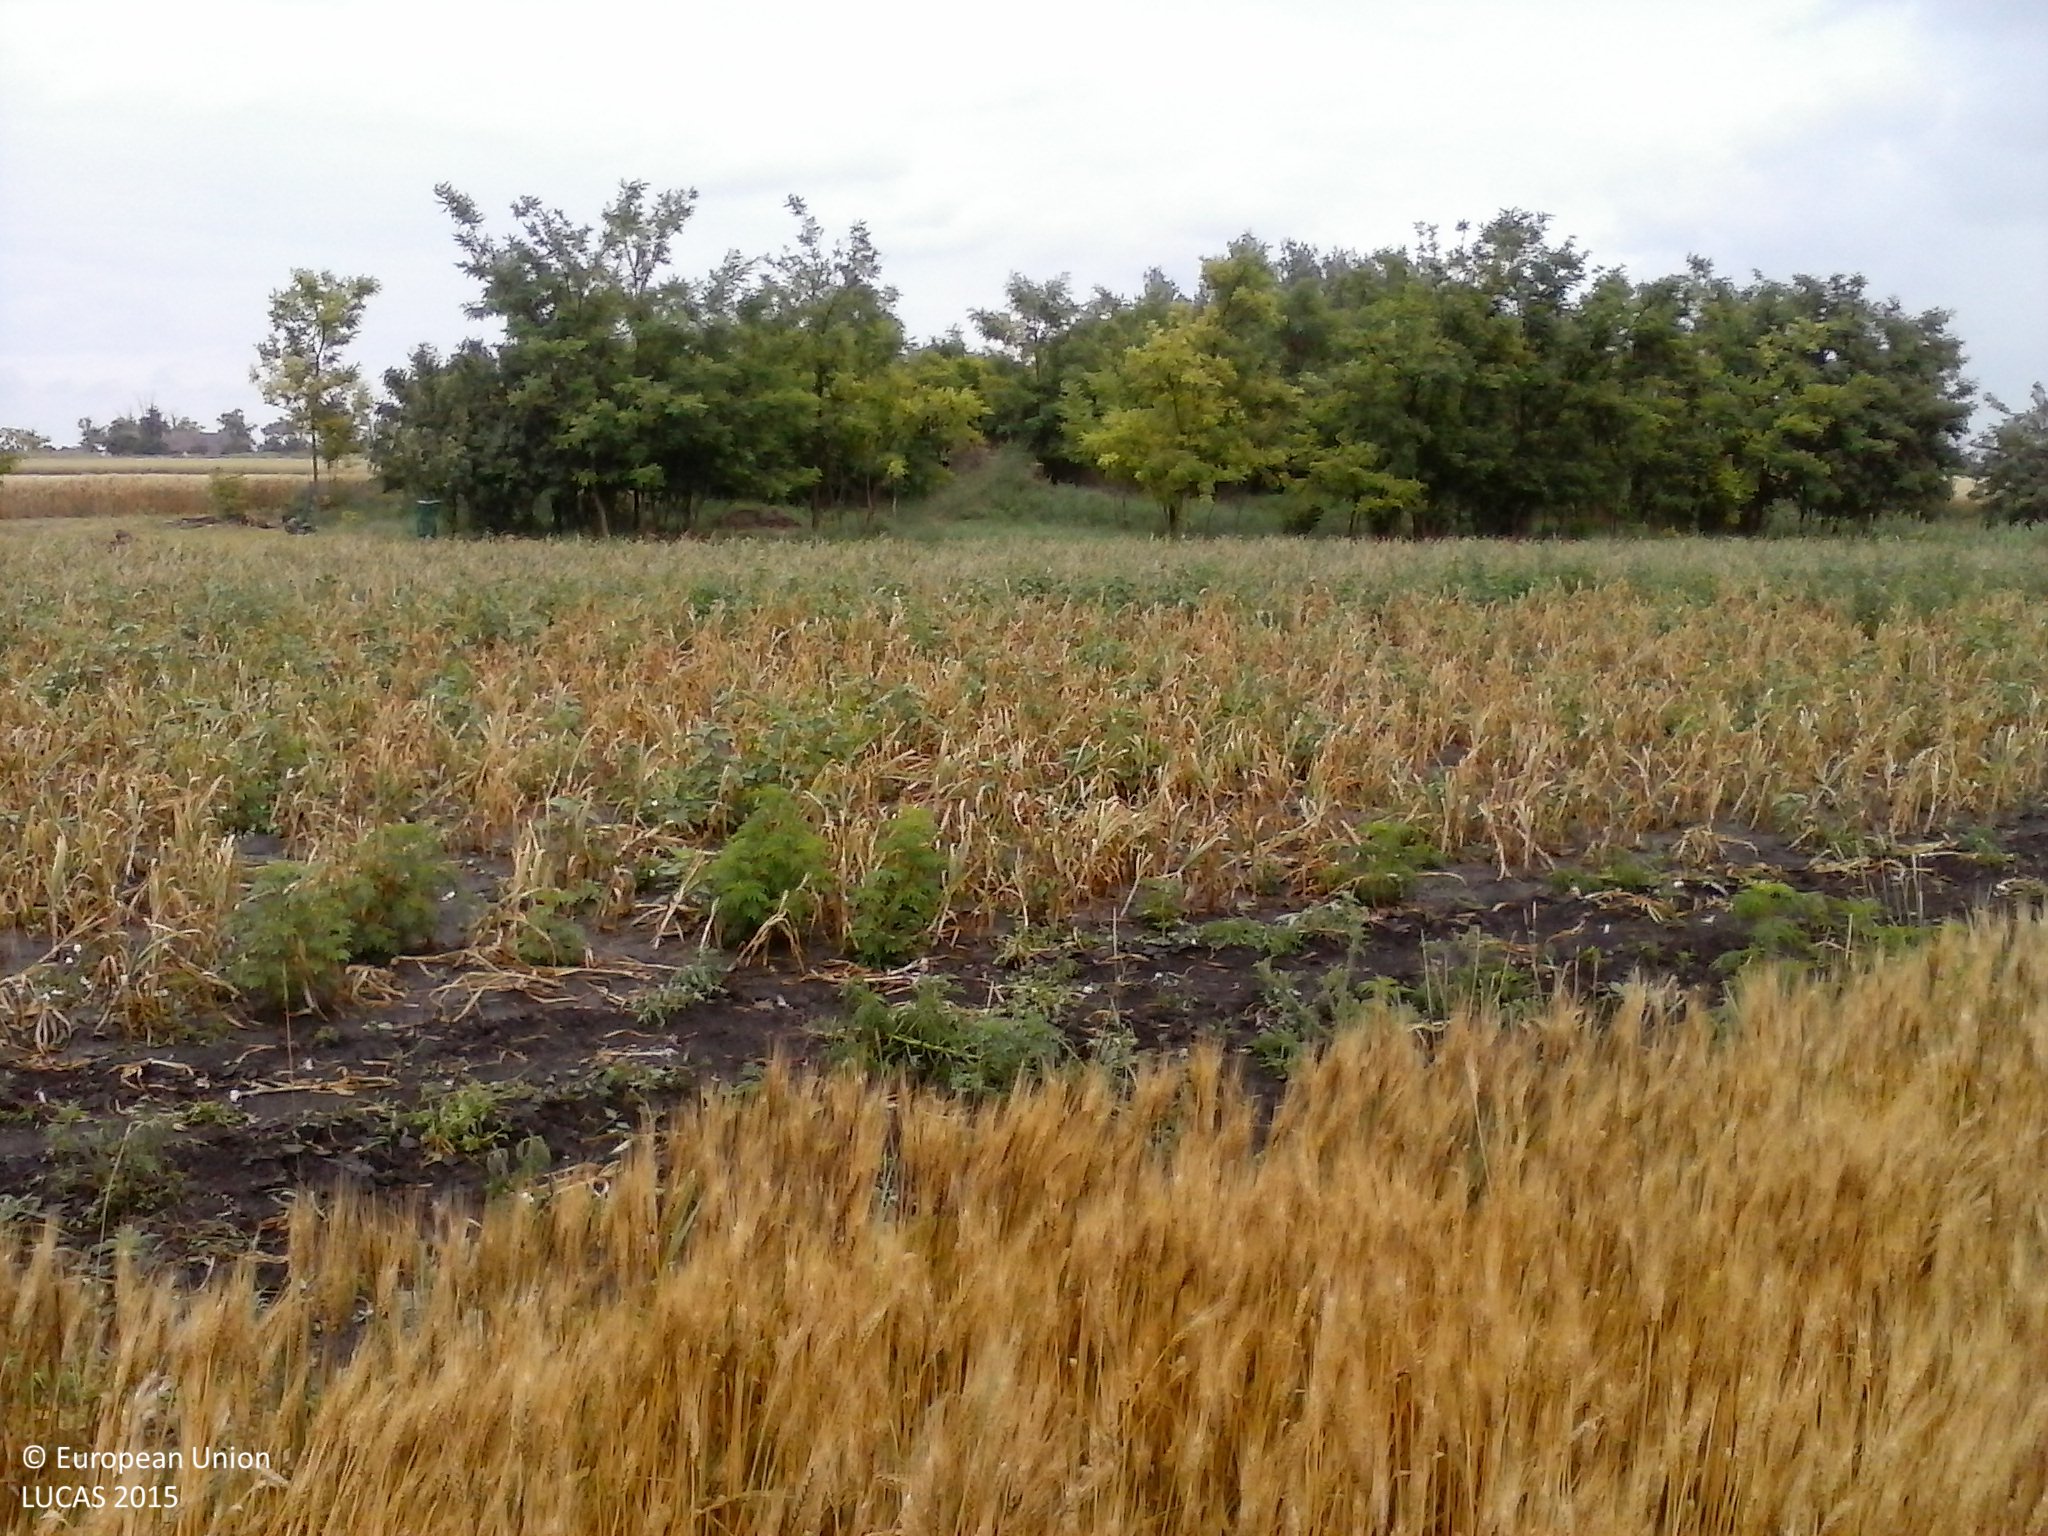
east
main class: Cropland
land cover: Barley
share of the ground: > 75 %
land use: Agriculture (excluding fallow land and kitchen gardens)
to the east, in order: Barley; Other root crops; Other bare soil; Common wheat; Rye; Other root crops; Common wheat; Spontaneously vegetated surfaces
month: June
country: HU
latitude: 46.3225
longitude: 20.5071
